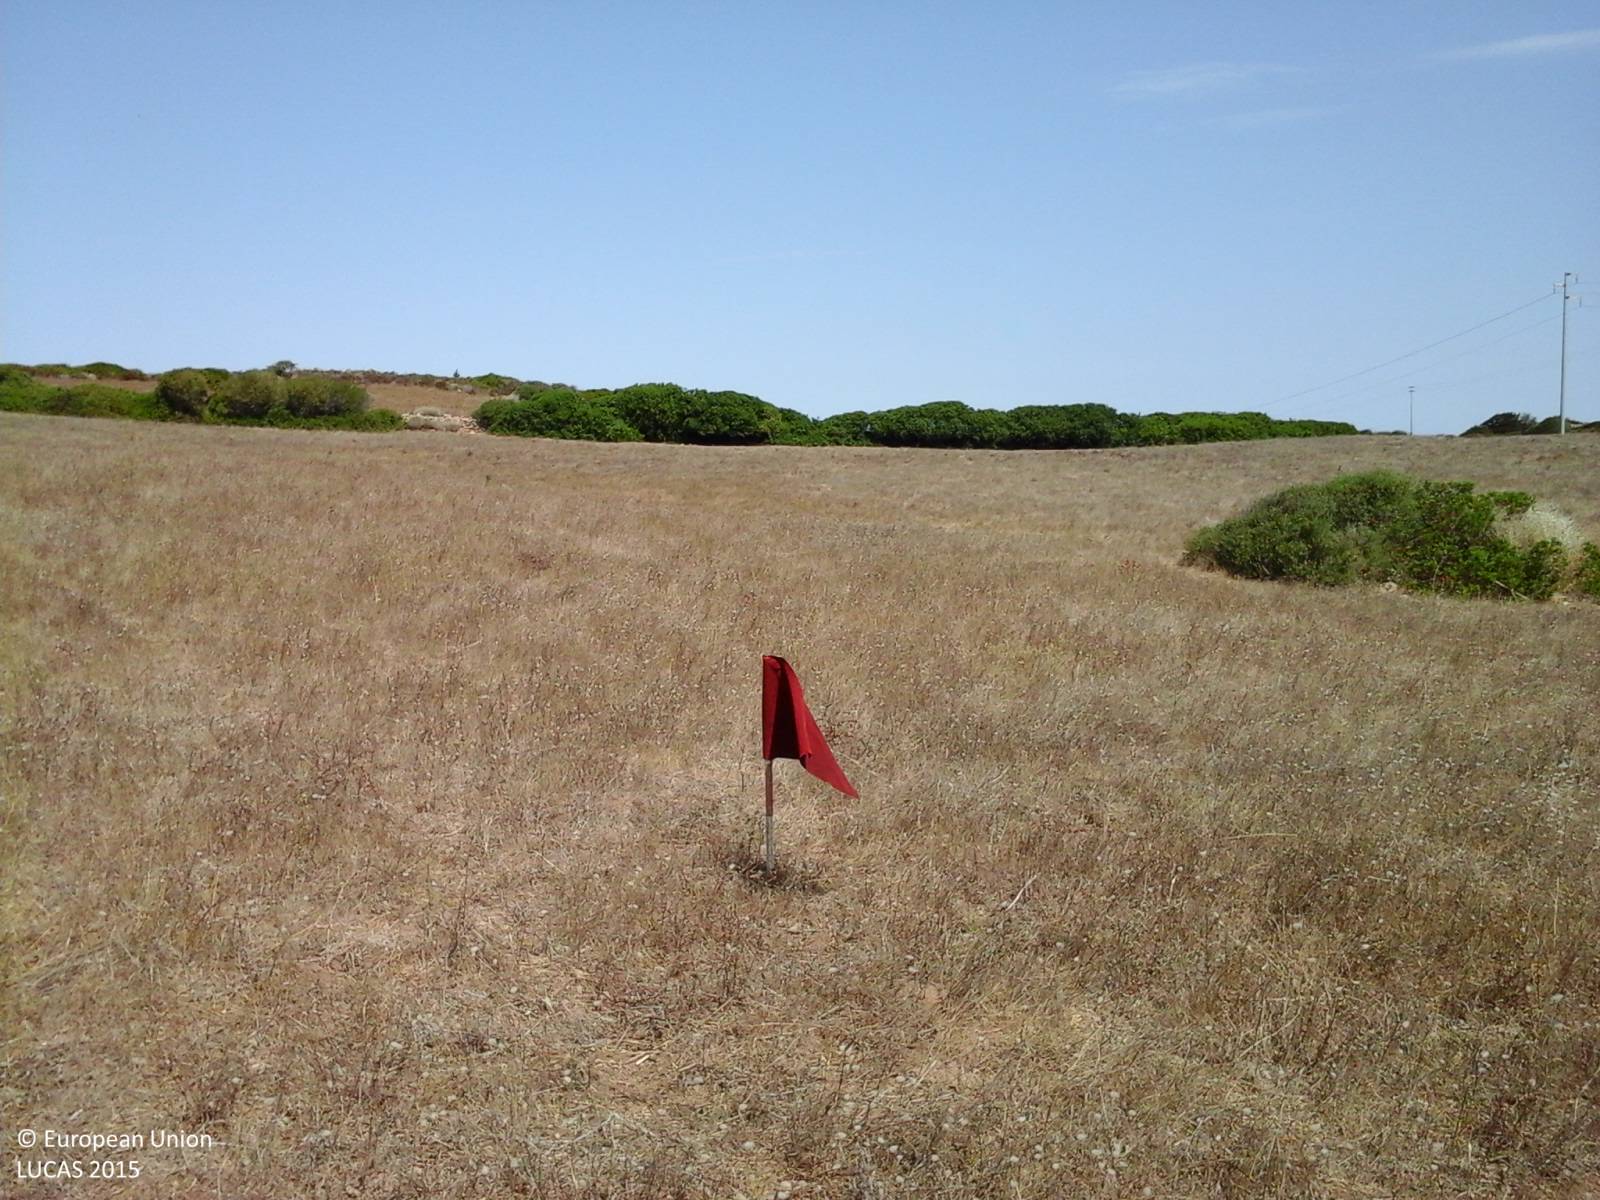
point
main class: Grassland
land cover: Grassland without tree/shrub cover
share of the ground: 50 - 75 %
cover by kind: herbaceous plants 100 %
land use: Agriculture (excluding fallow land and kitchen gardens)
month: July
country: IT
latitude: 41.2054
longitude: 9.2520
